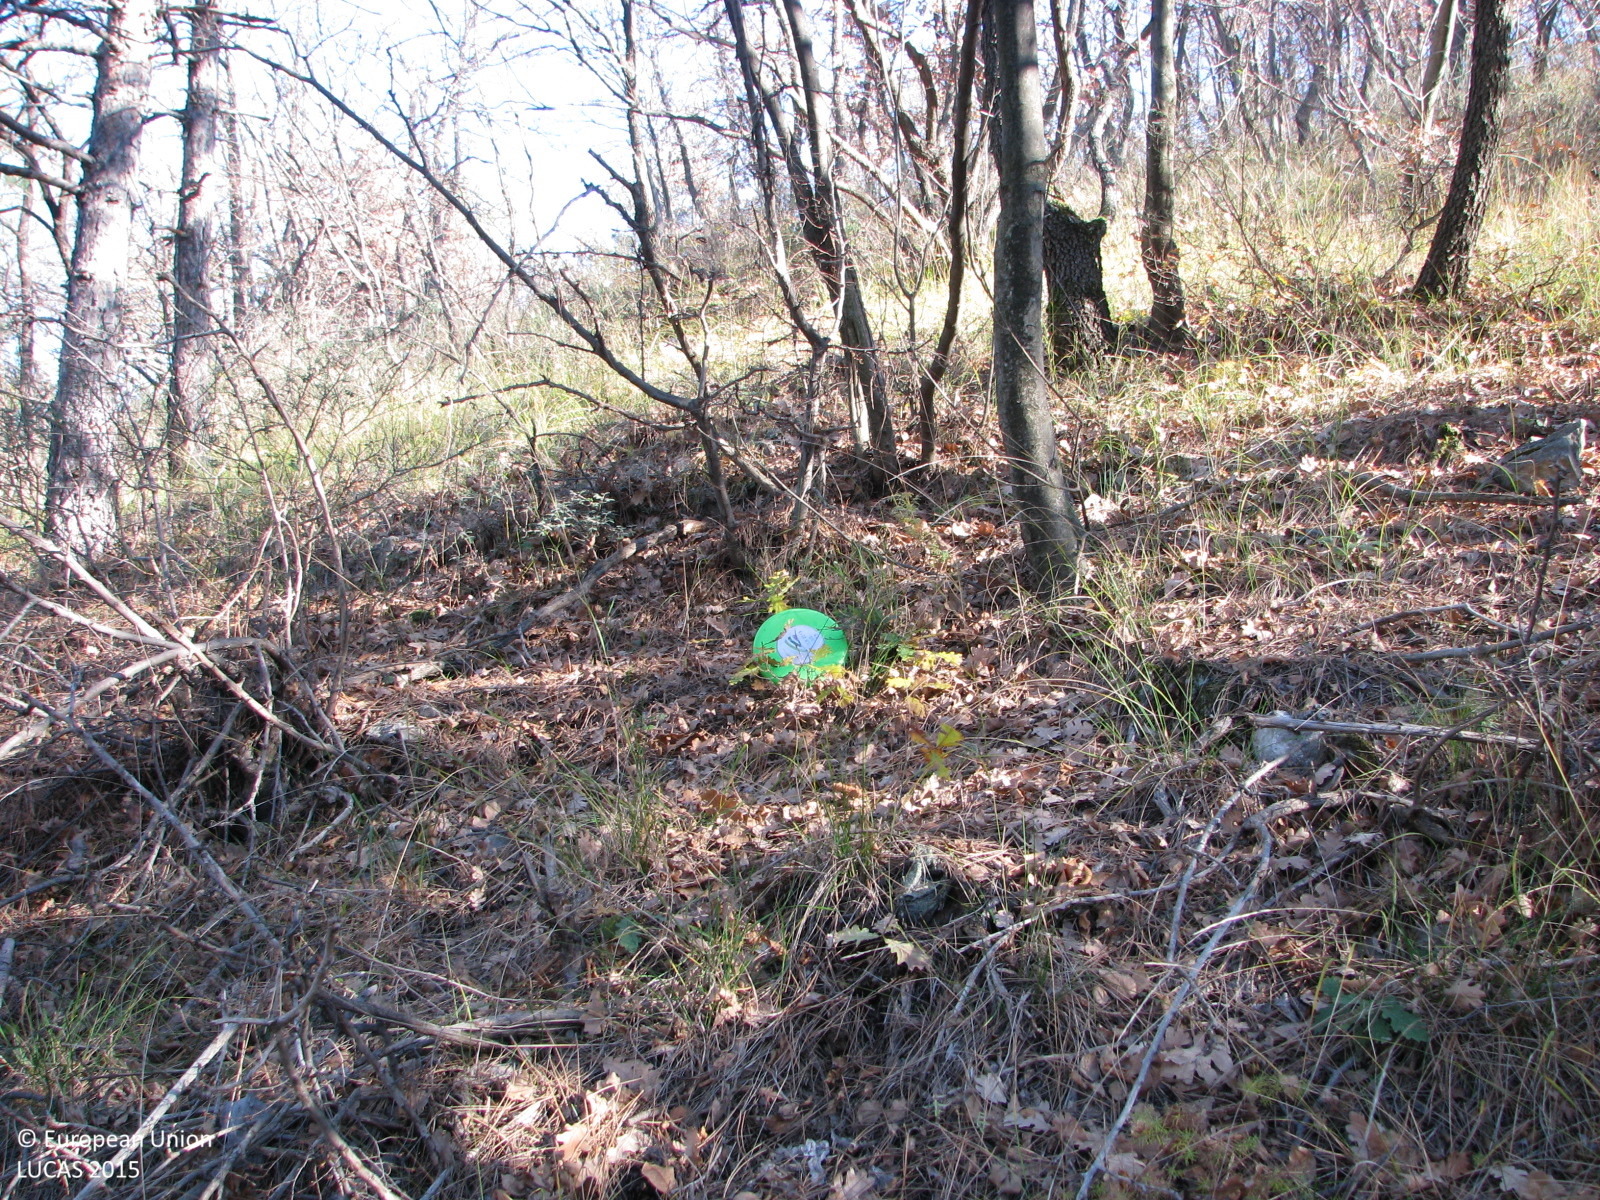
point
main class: Woodland
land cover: Pine dominated mixed woodland
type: hemiboreal forest and nemoral coniferous forest and mixed broadleaved-coniferous forest
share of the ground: > 75 %
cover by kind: coniferous forest trees 40 %, broadleaved forest trees 40 %, herbaceous plants 10 %, shrubs 5 %, unconsolidated bare surface 5 %
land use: Forestry
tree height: > 5 m
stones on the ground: < 10 %
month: December
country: BG
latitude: 42.1052
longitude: 24.2022
